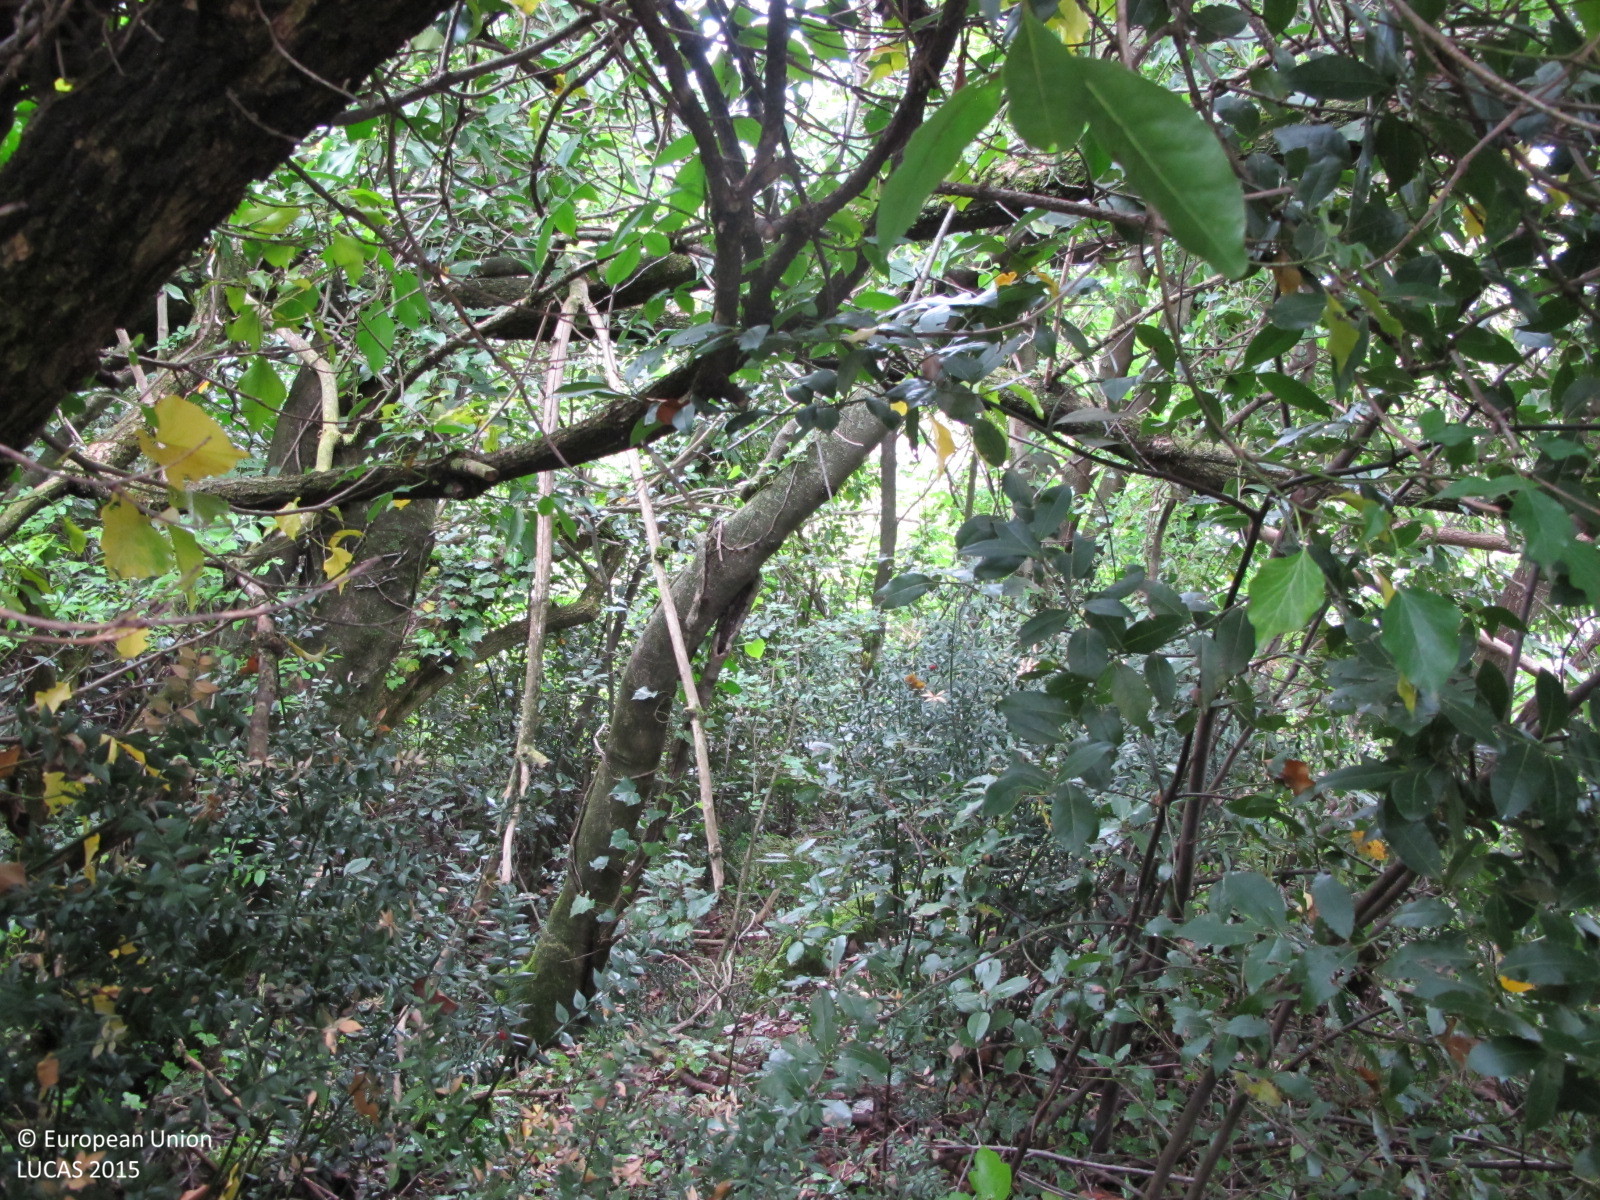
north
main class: Woodland
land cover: Broadleaved woodland
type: broadleaved evergreen forest
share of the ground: > 75 %
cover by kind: broadleaved forest trees 80 %, shrubs 15 %
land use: Semi-natural and natural areas not in use
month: April
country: HR
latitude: 45.3448
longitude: 14.2960
